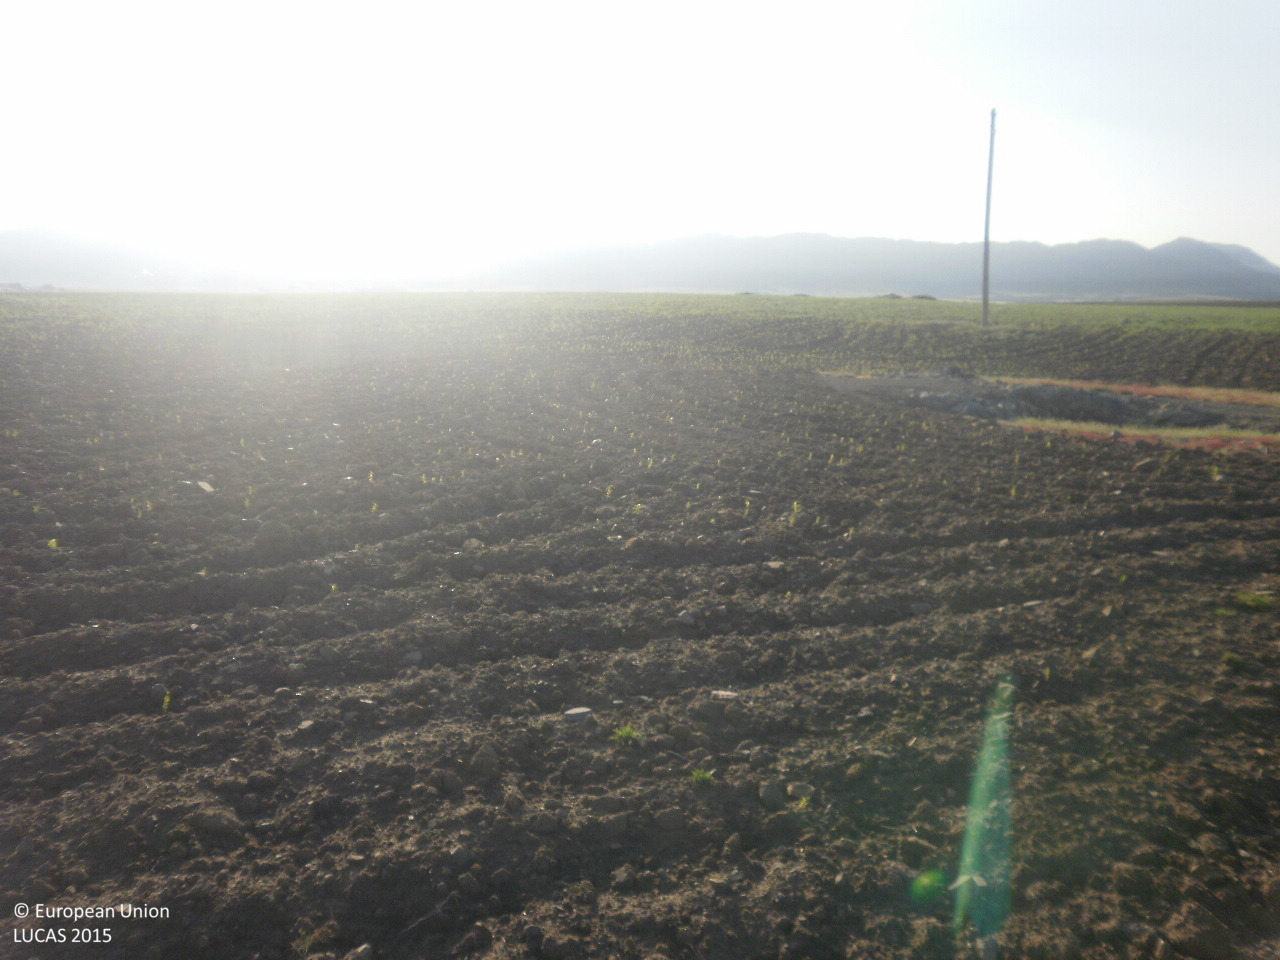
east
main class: Cropland
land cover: Dry pulses
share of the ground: > 75 %
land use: Agriculture (excluding fallow land and kitchen gardens)
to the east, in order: Dry pulses
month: April
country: ES
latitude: 38.7996
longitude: -5.1998
